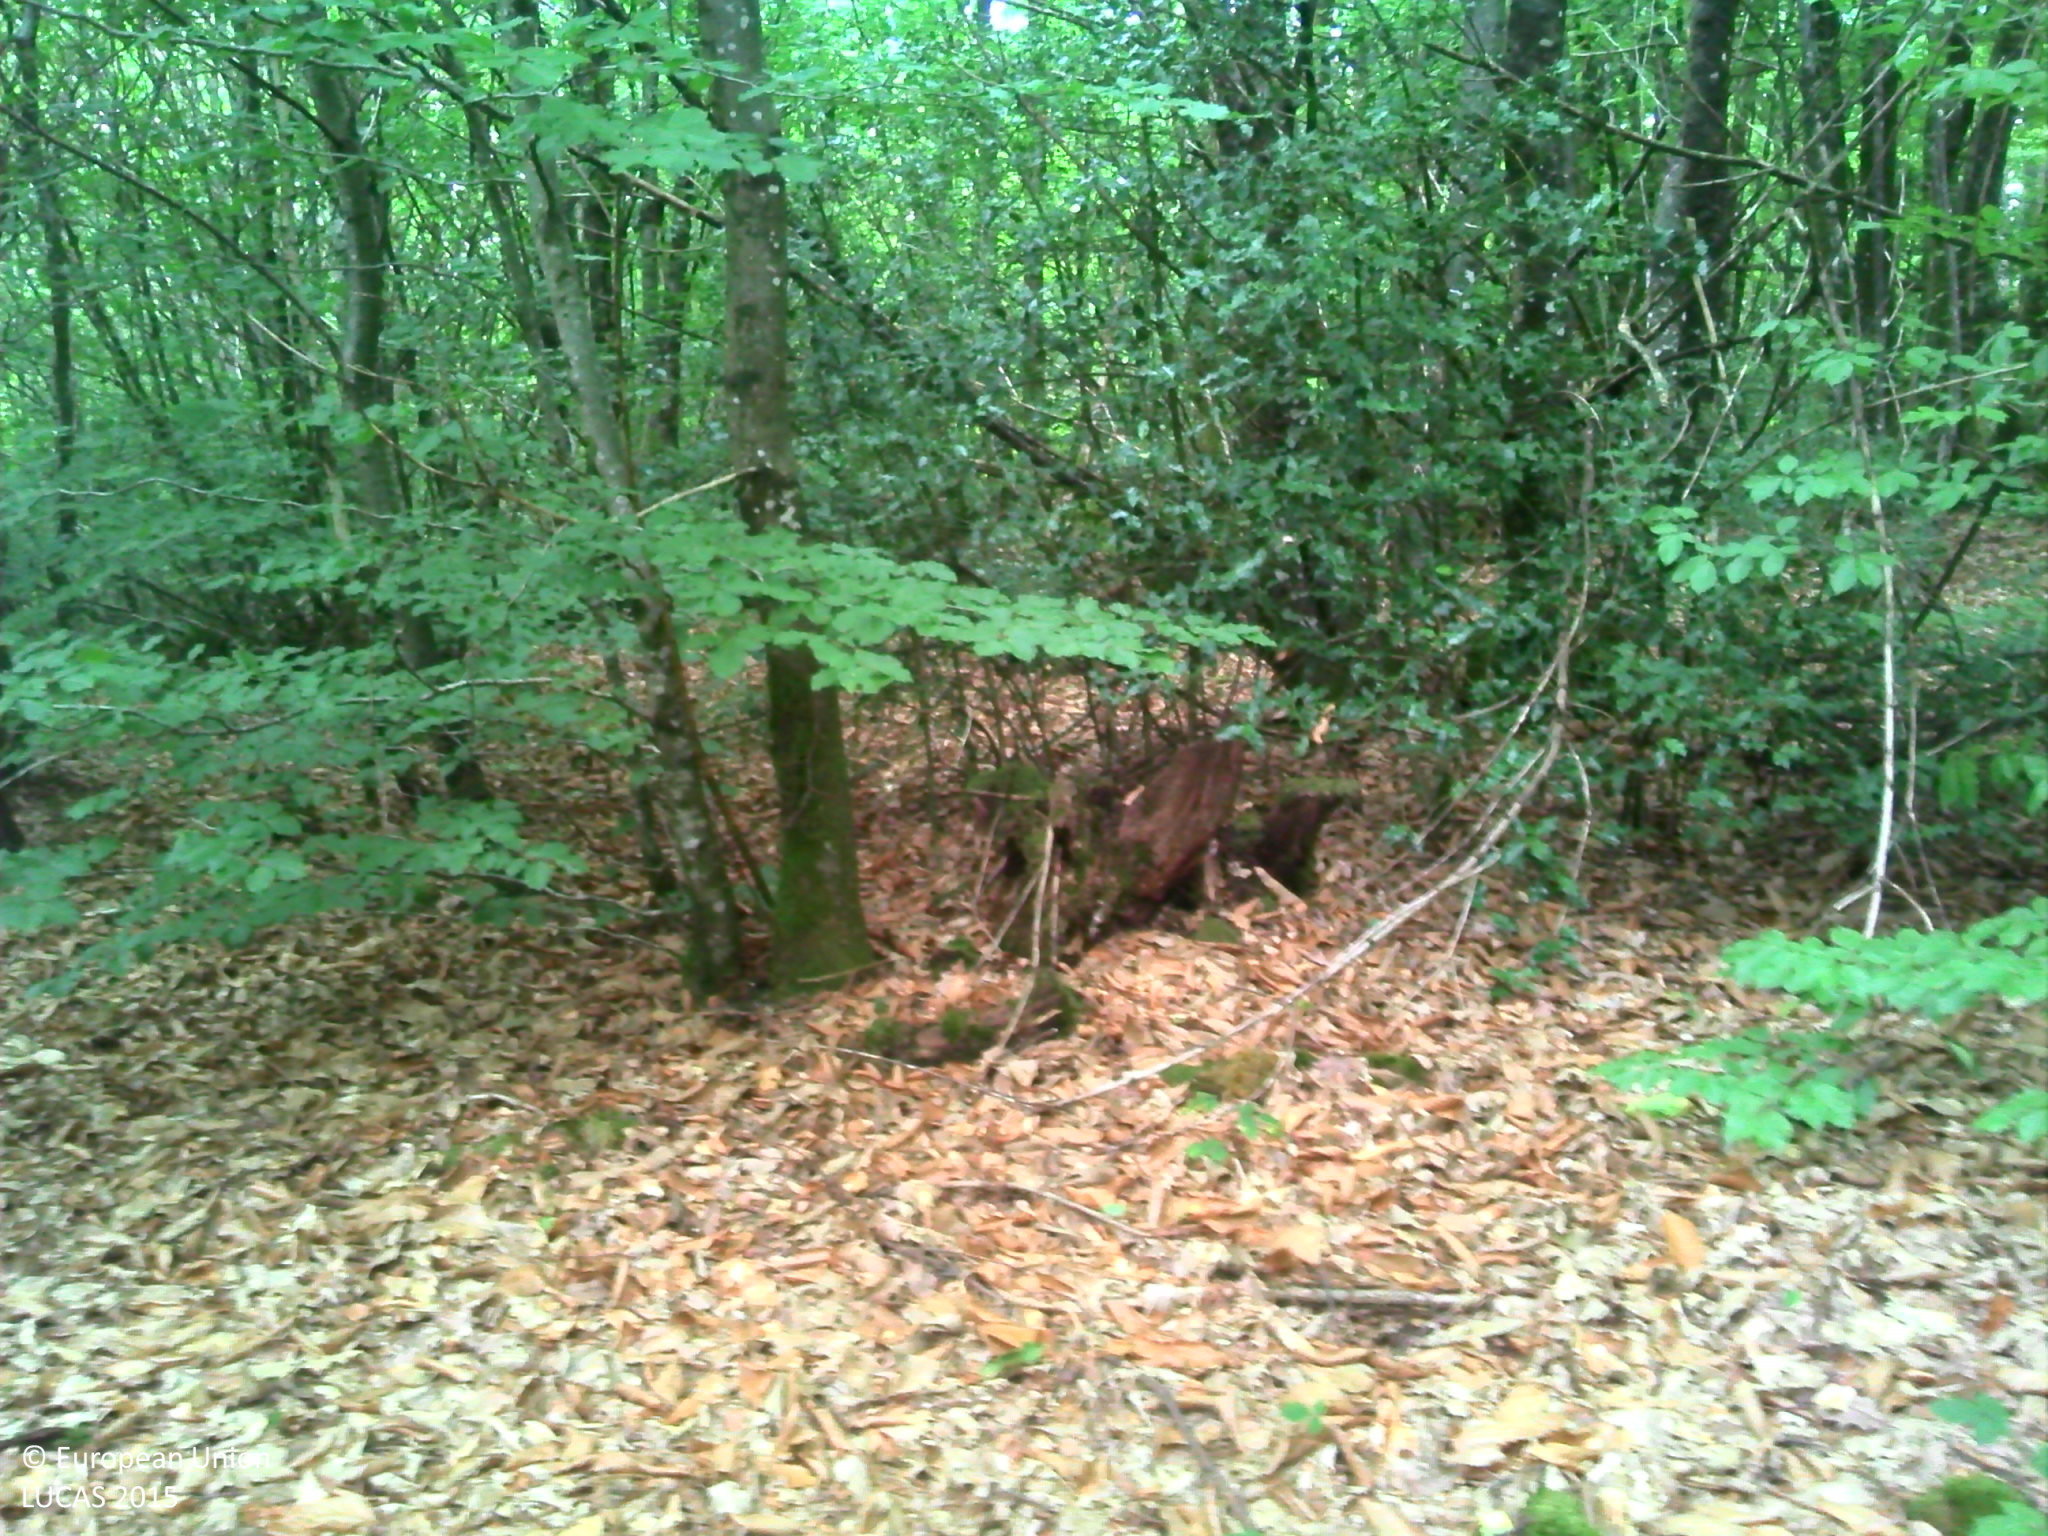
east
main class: Woodland
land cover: Broadleaved woodland
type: acidophilous oak and oak-birch forest
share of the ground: > 75 %
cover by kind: broadleaved forest trees 100 %
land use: Semi-natural and natural areas not in use
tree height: > 5 m
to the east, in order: Broadleaved woodland; Tracks; Broadleaved woodland; Tracks; Broadleaved woodland
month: August
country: FR
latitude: 45.8938
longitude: 1.6027
